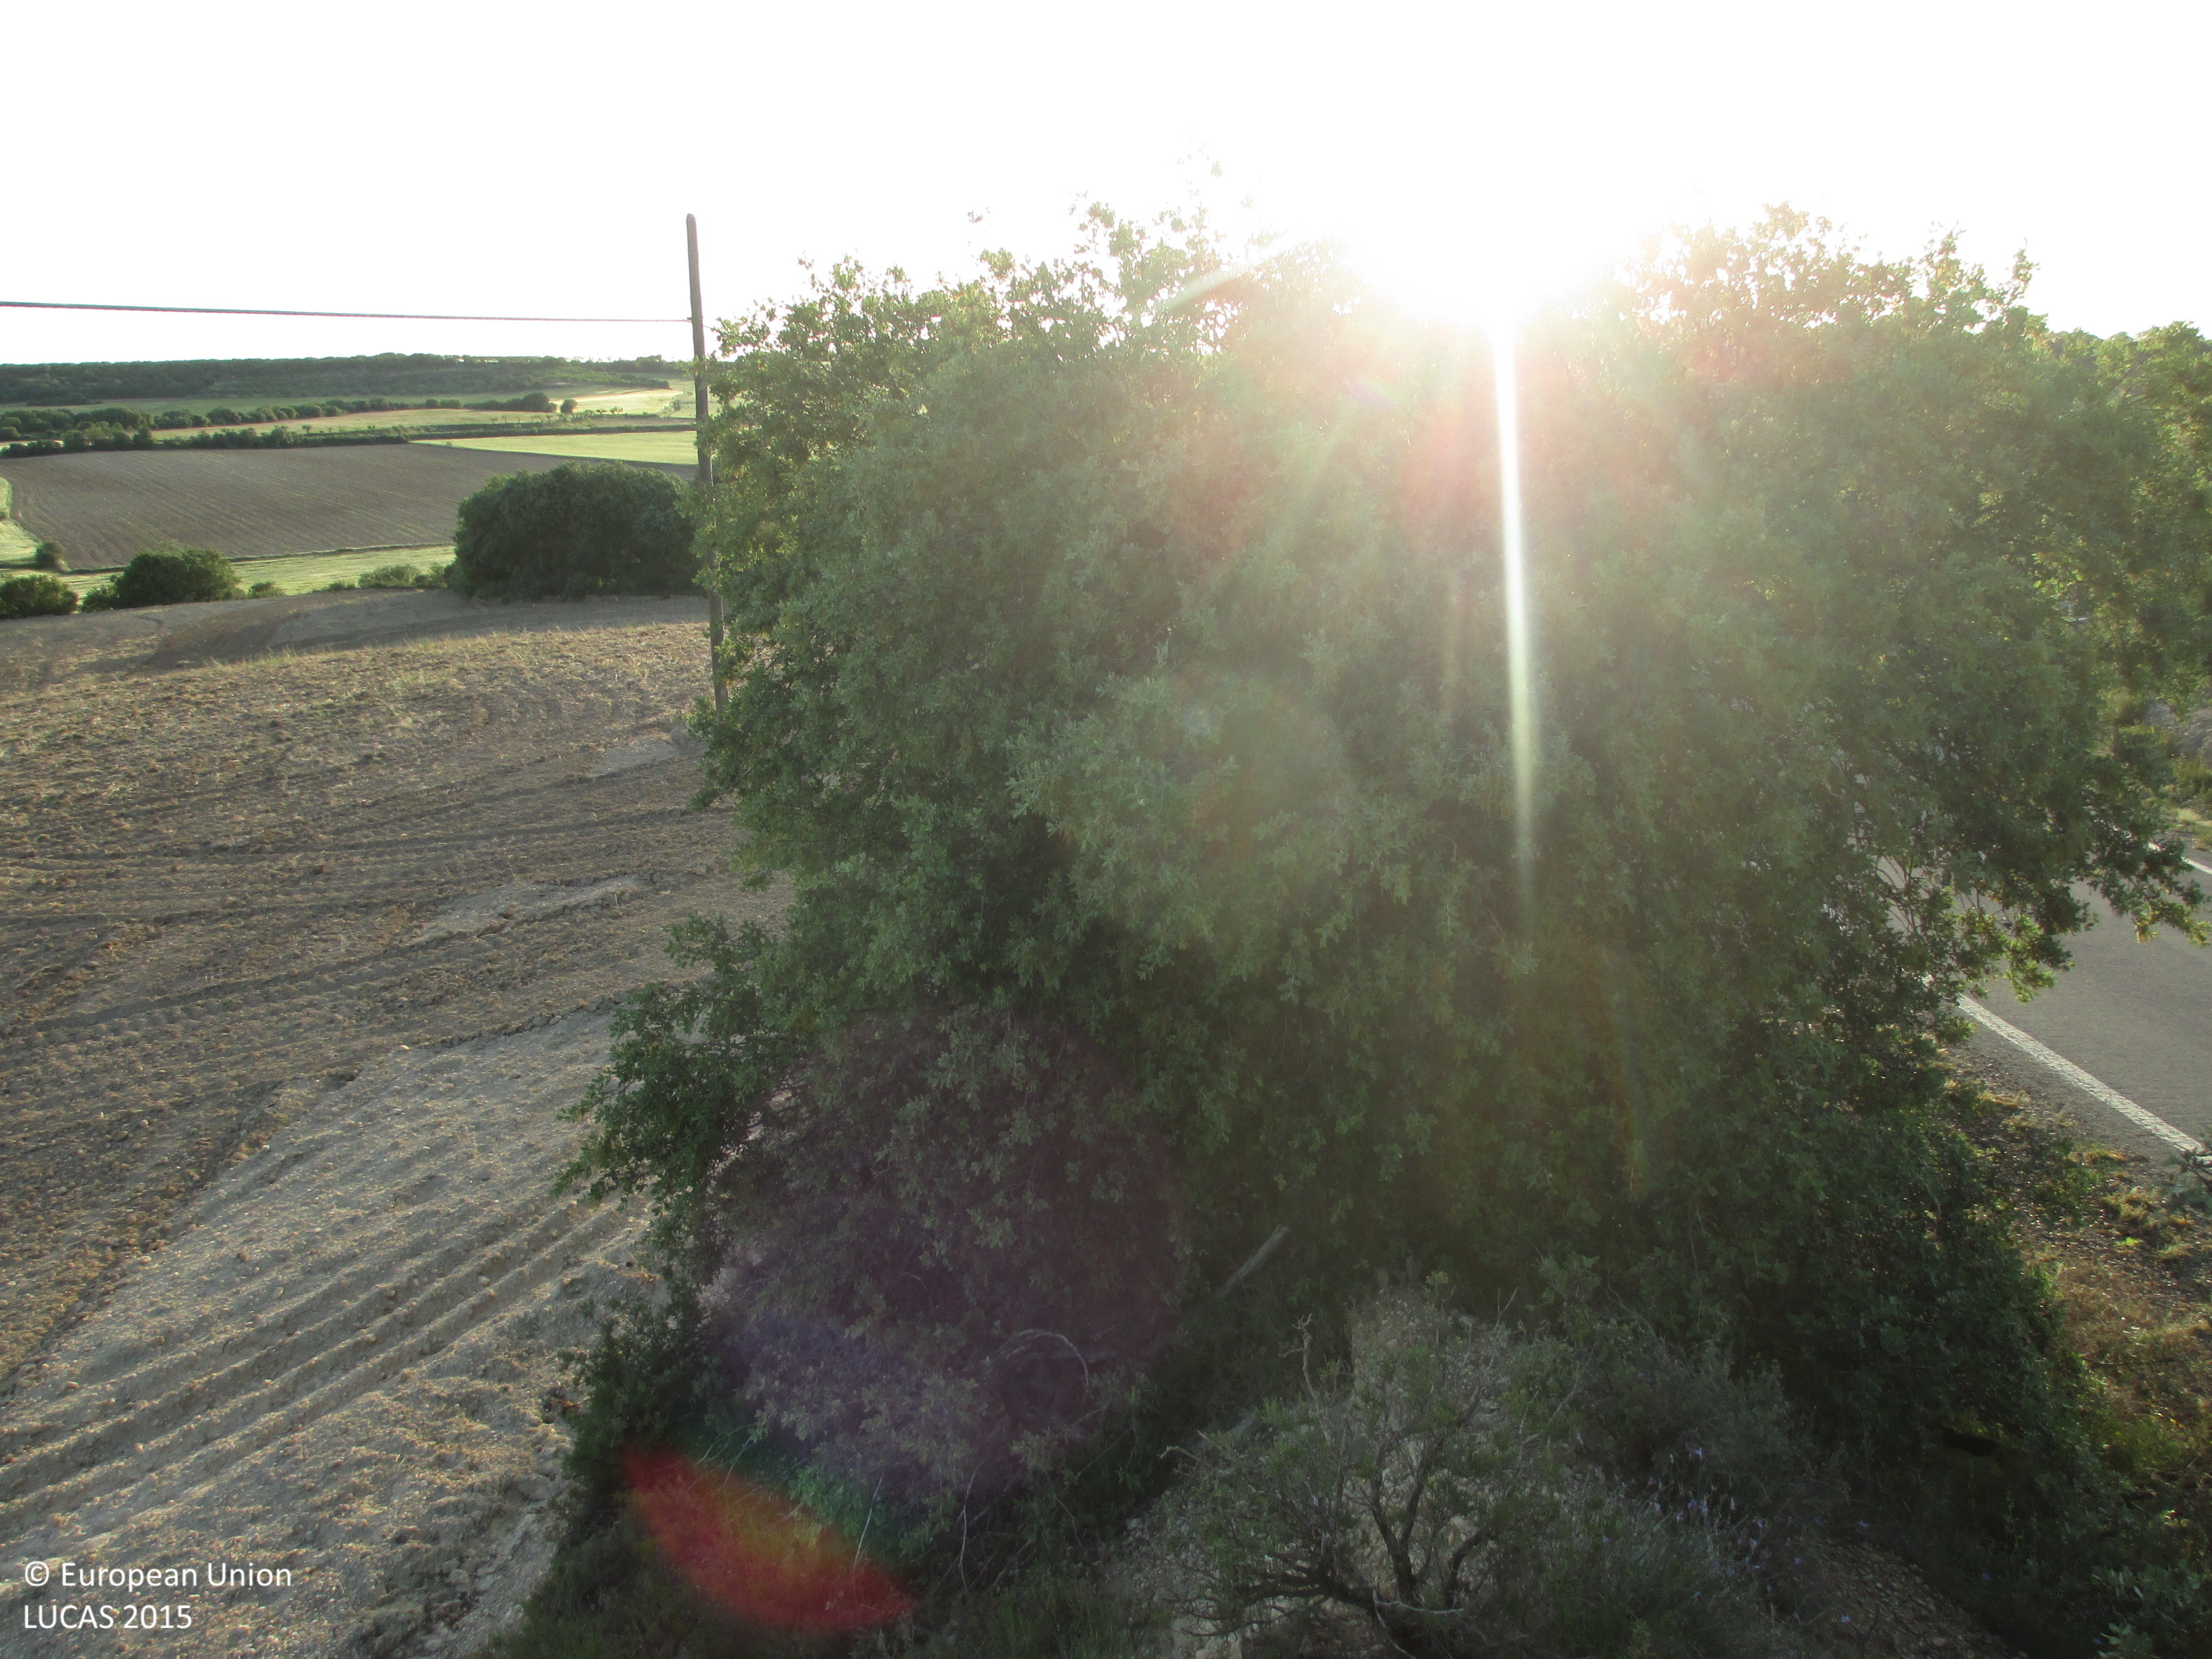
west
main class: Woodland
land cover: Broadleaved woodland
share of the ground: > 75 %
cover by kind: broadleaved forest trees 90 %, shrubs 10 %
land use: Semi-natural and natural areas not in use
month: May
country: ES
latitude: 42.0454
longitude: -0.0348
